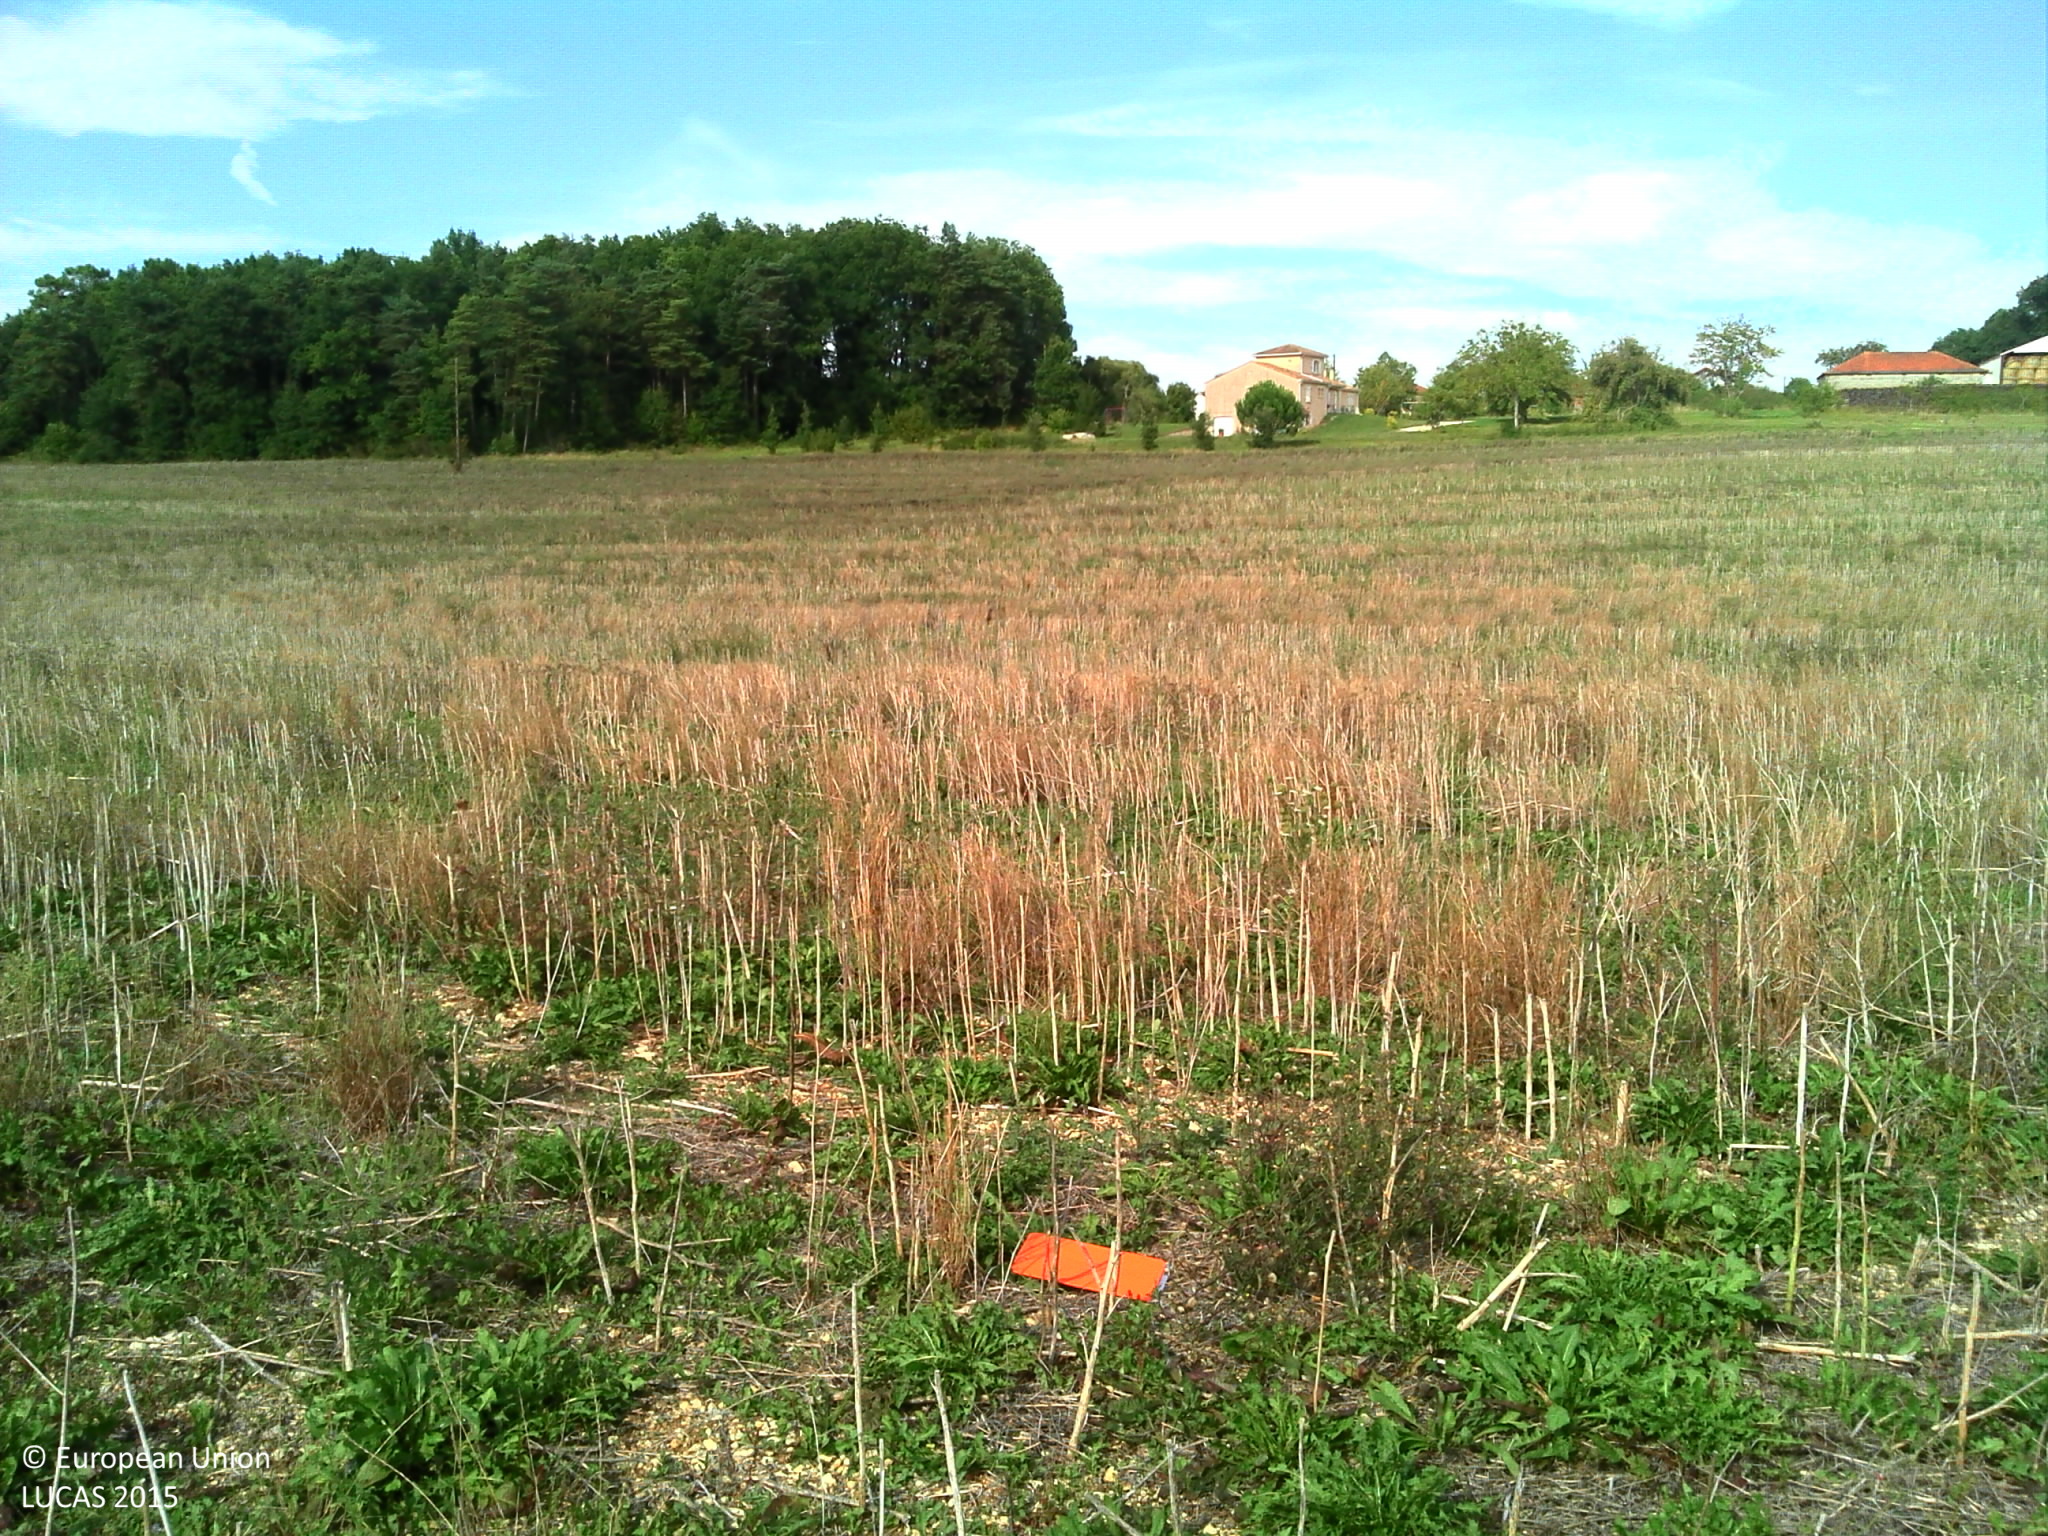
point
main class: Grassland
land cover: Spontaneously vegetated surfaces
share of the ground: 50 - 75 %
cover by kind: herbaceous plants 60 %, consolidated bare surface 40 %
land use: Agriculture (excluding fallow land and kitchen gardens)
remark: Harvested field
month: August
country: FR
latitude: 45.3989
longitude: 0.4701
